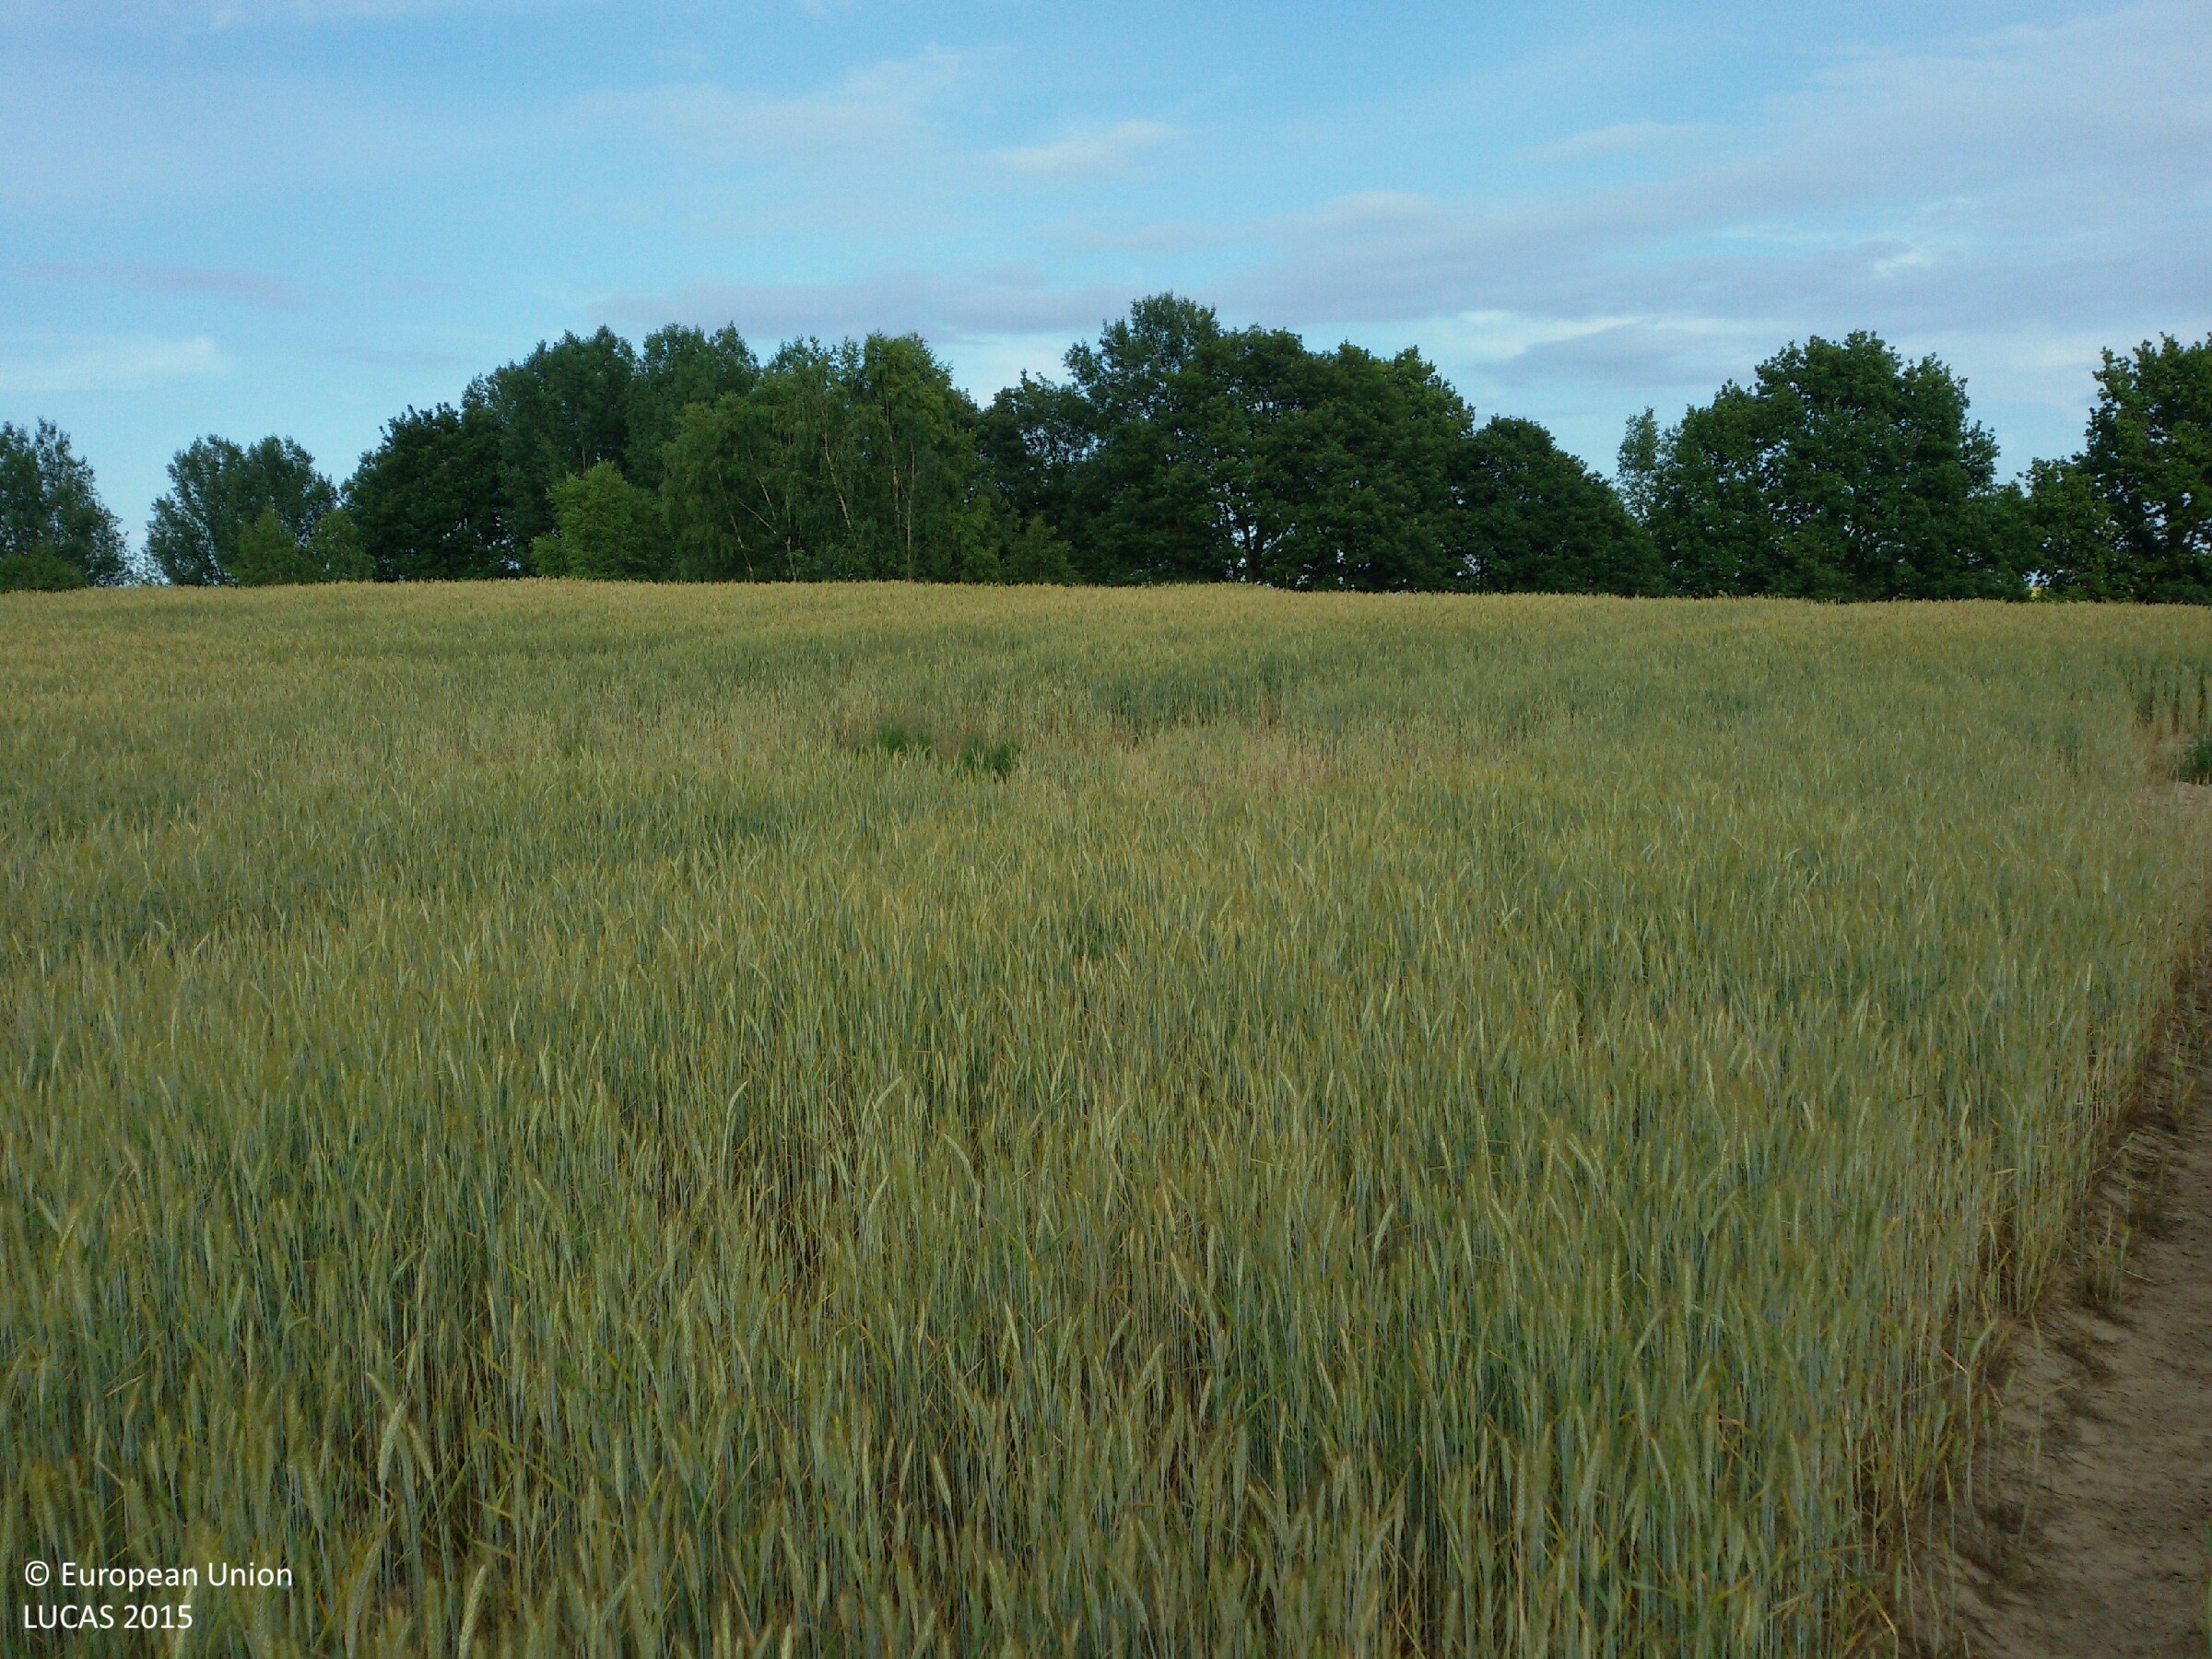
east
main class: Cropland
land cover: Common wheat
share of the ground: > 75 %
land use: Agriculture (excluding fallow land and kitchen gardens)
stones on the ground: < 10 %
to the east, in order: Common wheat; Other mixed woodland; Common wheat
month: June
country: PL
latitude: 53.4468
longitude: 20.1362
